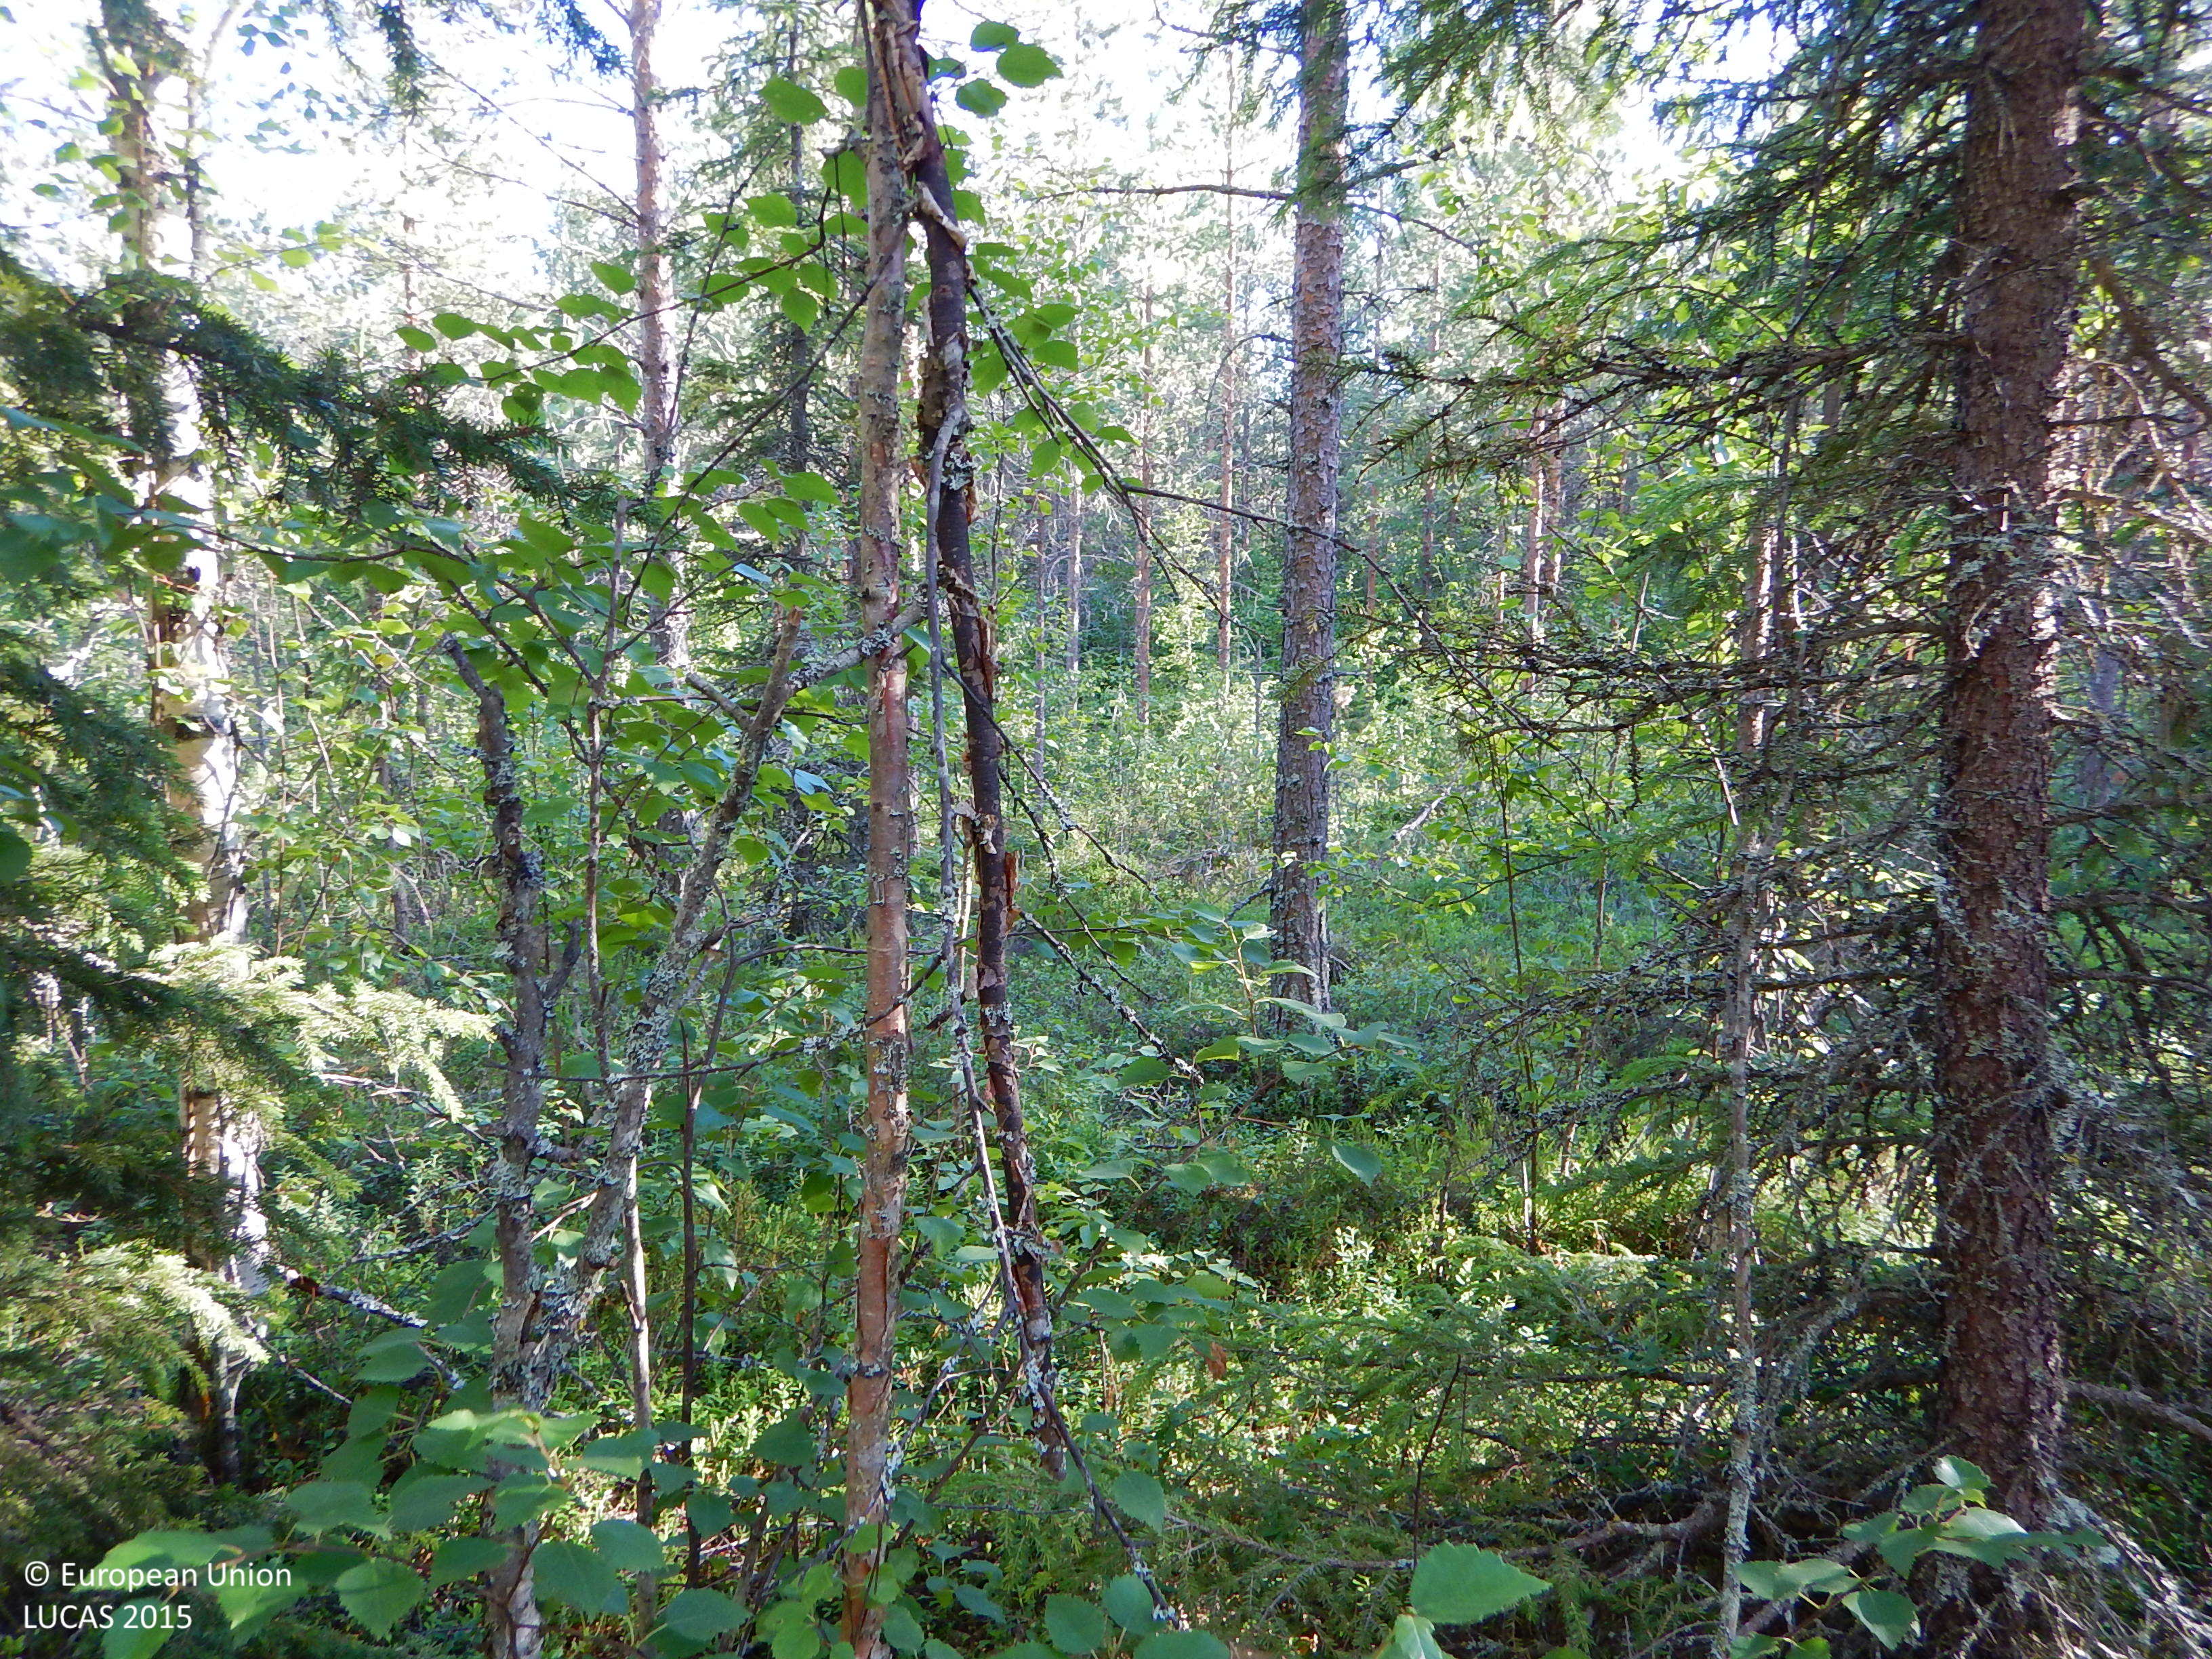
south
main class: Woodland
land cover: Pine dominated coniferous woodland
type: boreal forest
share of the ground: 50 - 75 %
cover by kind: coniferous forest trees 50 %, herbaceous plants 15 %, lichens and mosses 15 %, broadleaved forest trees 10 %, shrubs 10 %
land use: Forestry
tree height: > 5 m
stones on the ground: < 10 %
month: July
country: SE
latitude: 64.7865
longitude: 20.9388
